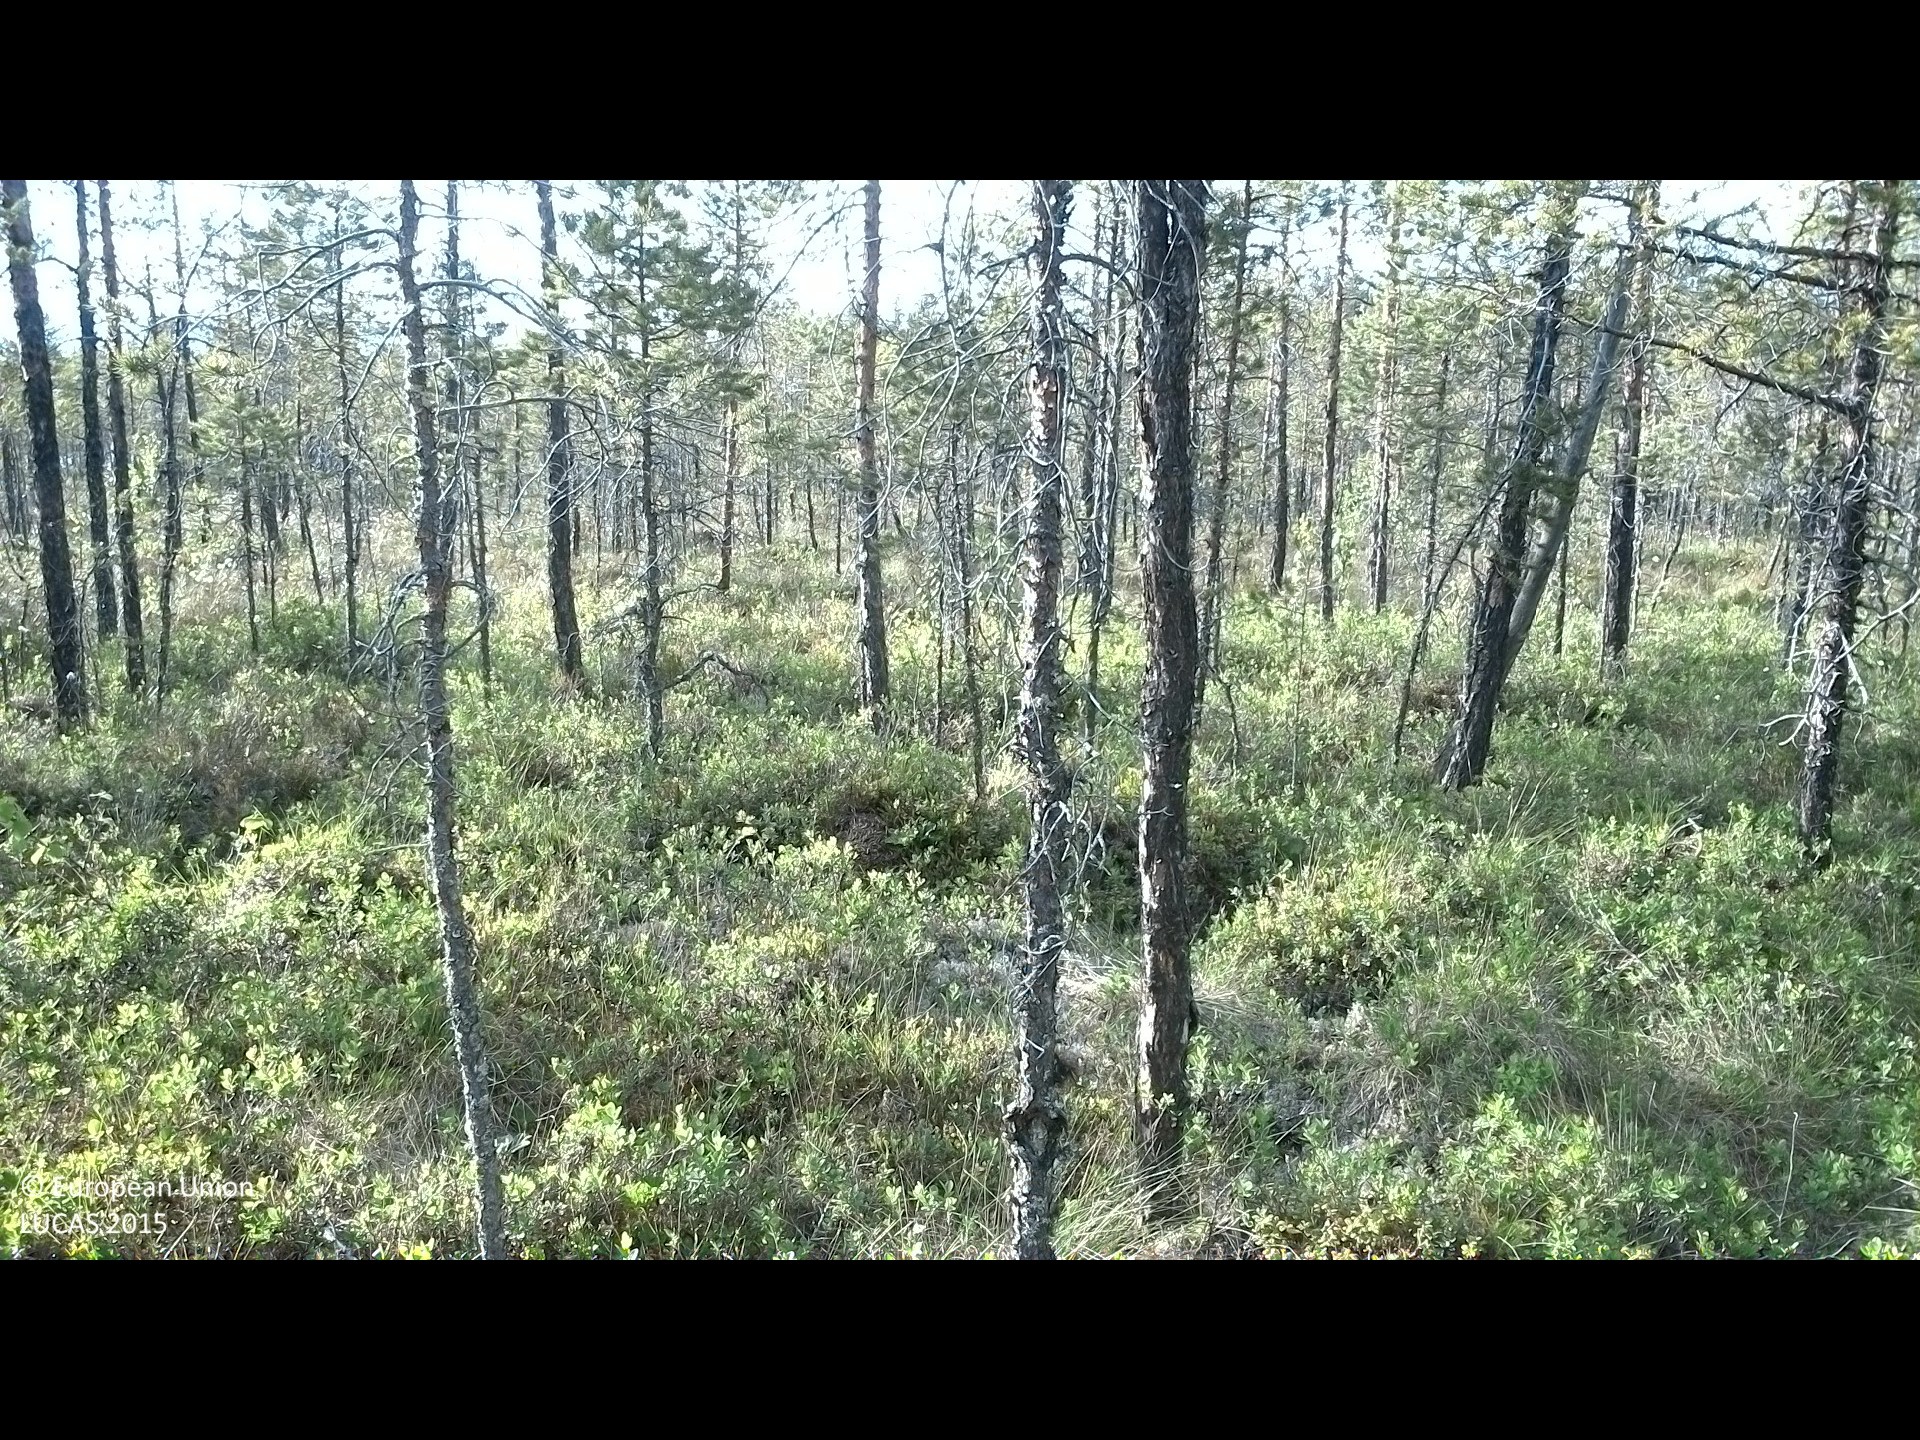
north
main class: Woodland
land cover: Pine dominated coniferous woodland
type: boreal forest
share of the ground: 10 - 25 %
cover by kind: shrubs 40 %, coniferous forest trees 25 %, lichens and mosses 20 %, herbaceous plants 15 %
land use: Forestry
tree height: < 5 m
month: June
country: SE
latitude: 61.9524
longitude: 15.9489
